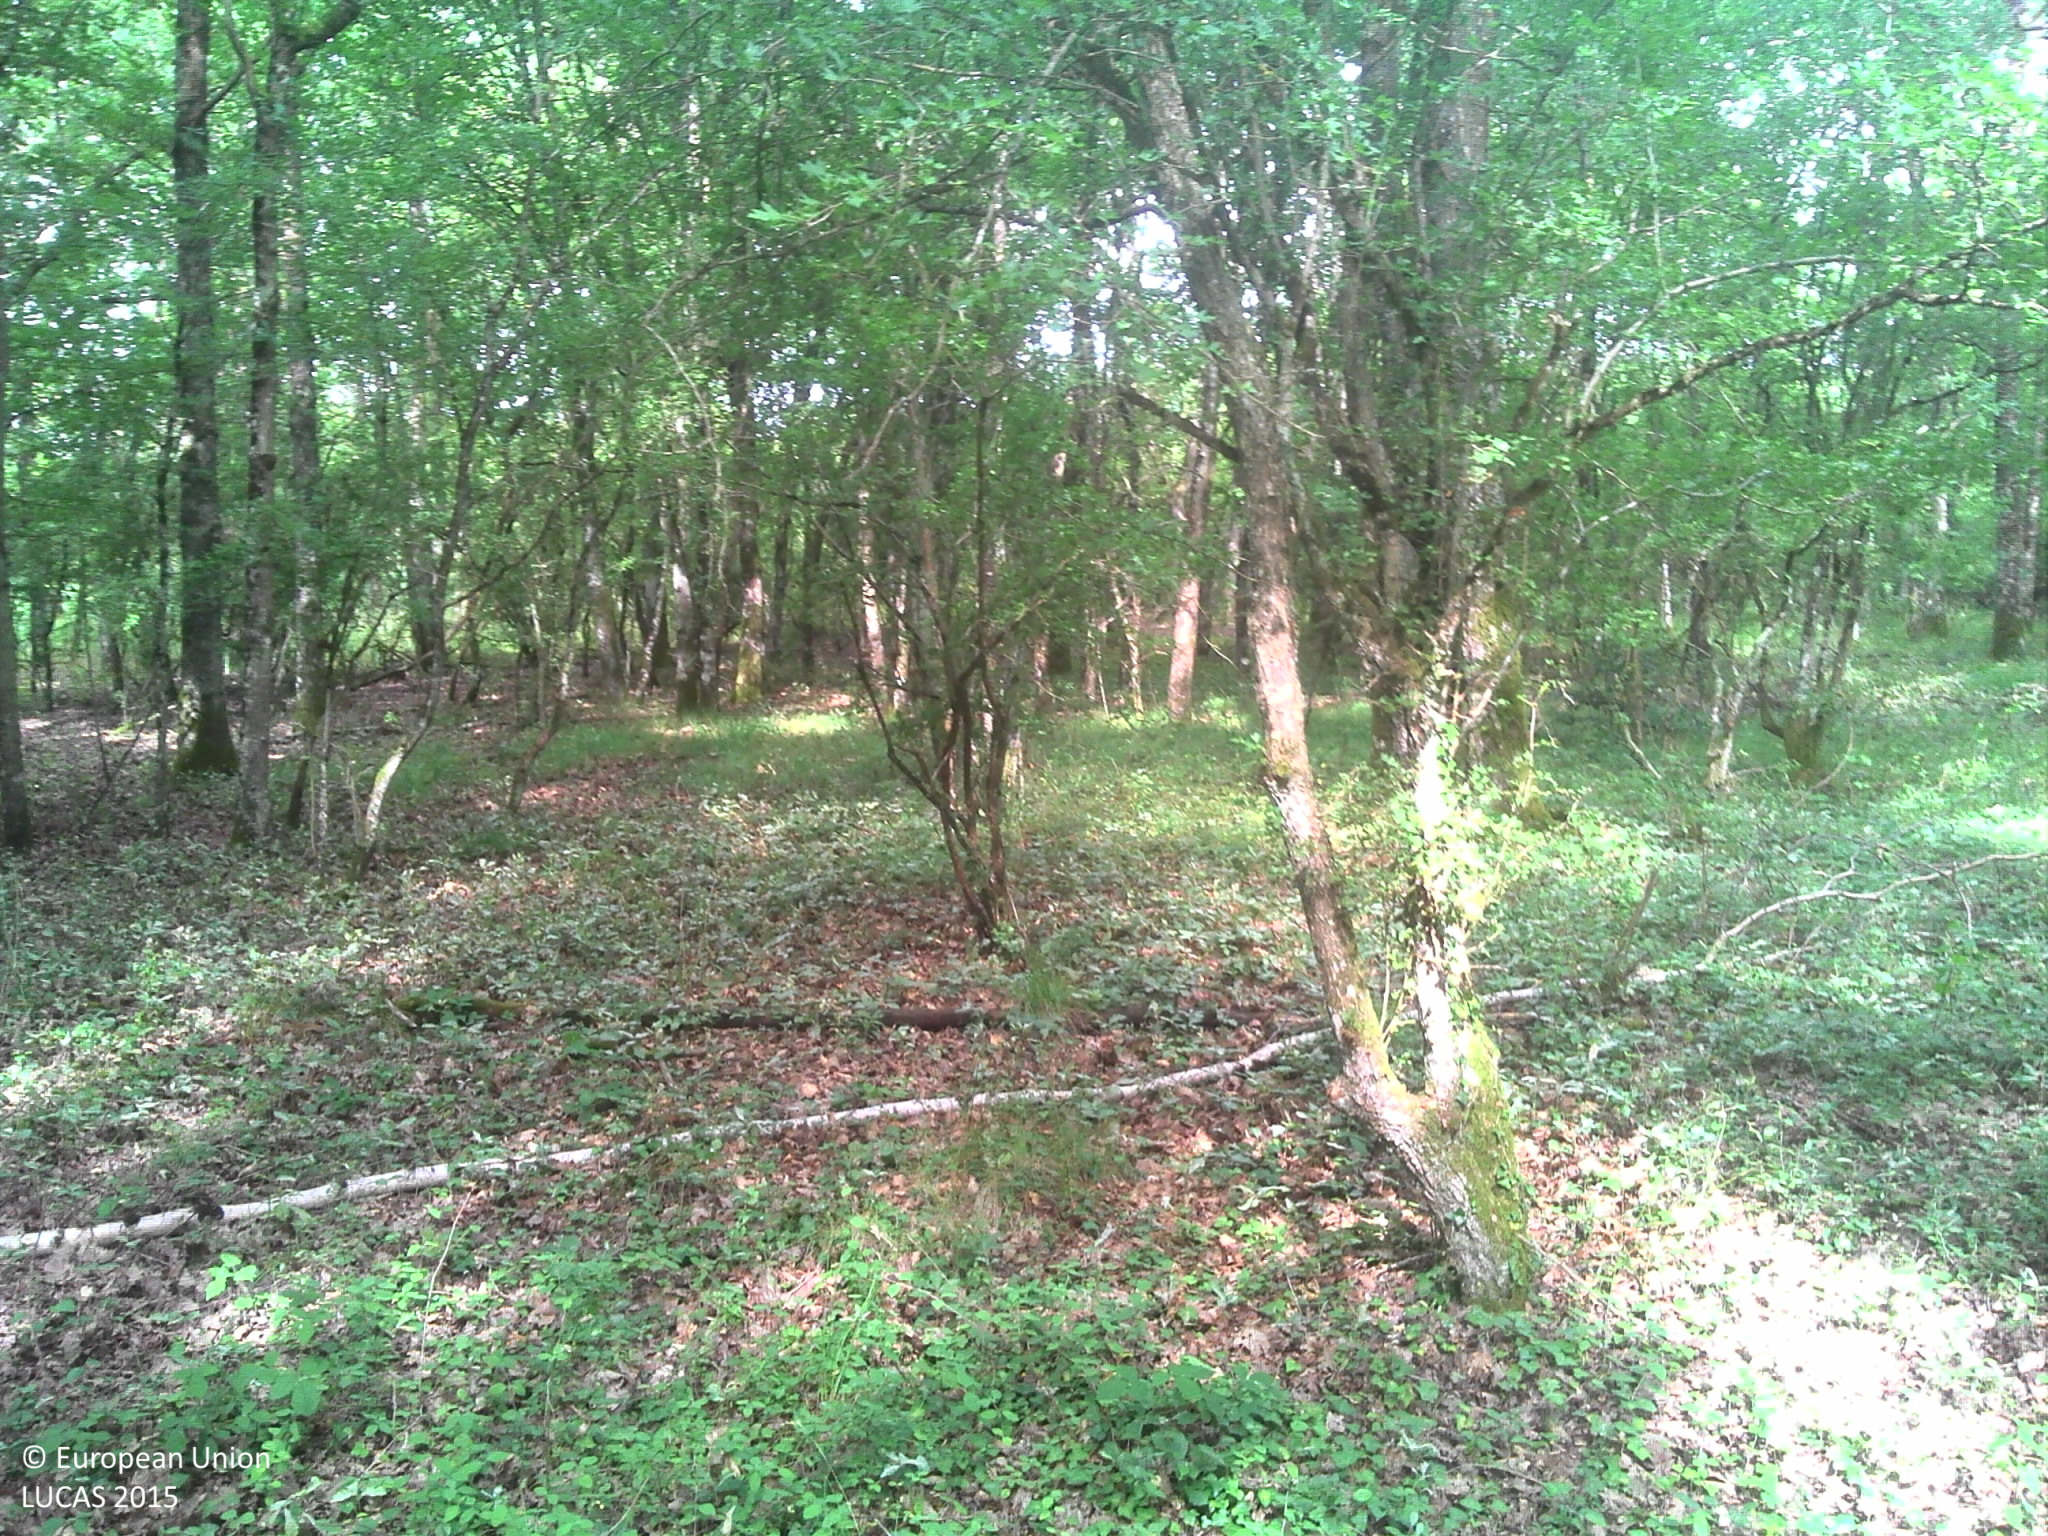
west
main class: Woodland
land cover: Broadleaved woodland
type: mesophytic deciduous forest
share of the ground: > 75 %
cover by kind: herbaceous plants 40 %, unconsolidated bare surface 40 %, broadleaved forest trees 20 %
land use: Forestry
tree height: > 5 m
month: June
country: FR
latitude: 47.3658
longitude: 1.4454
